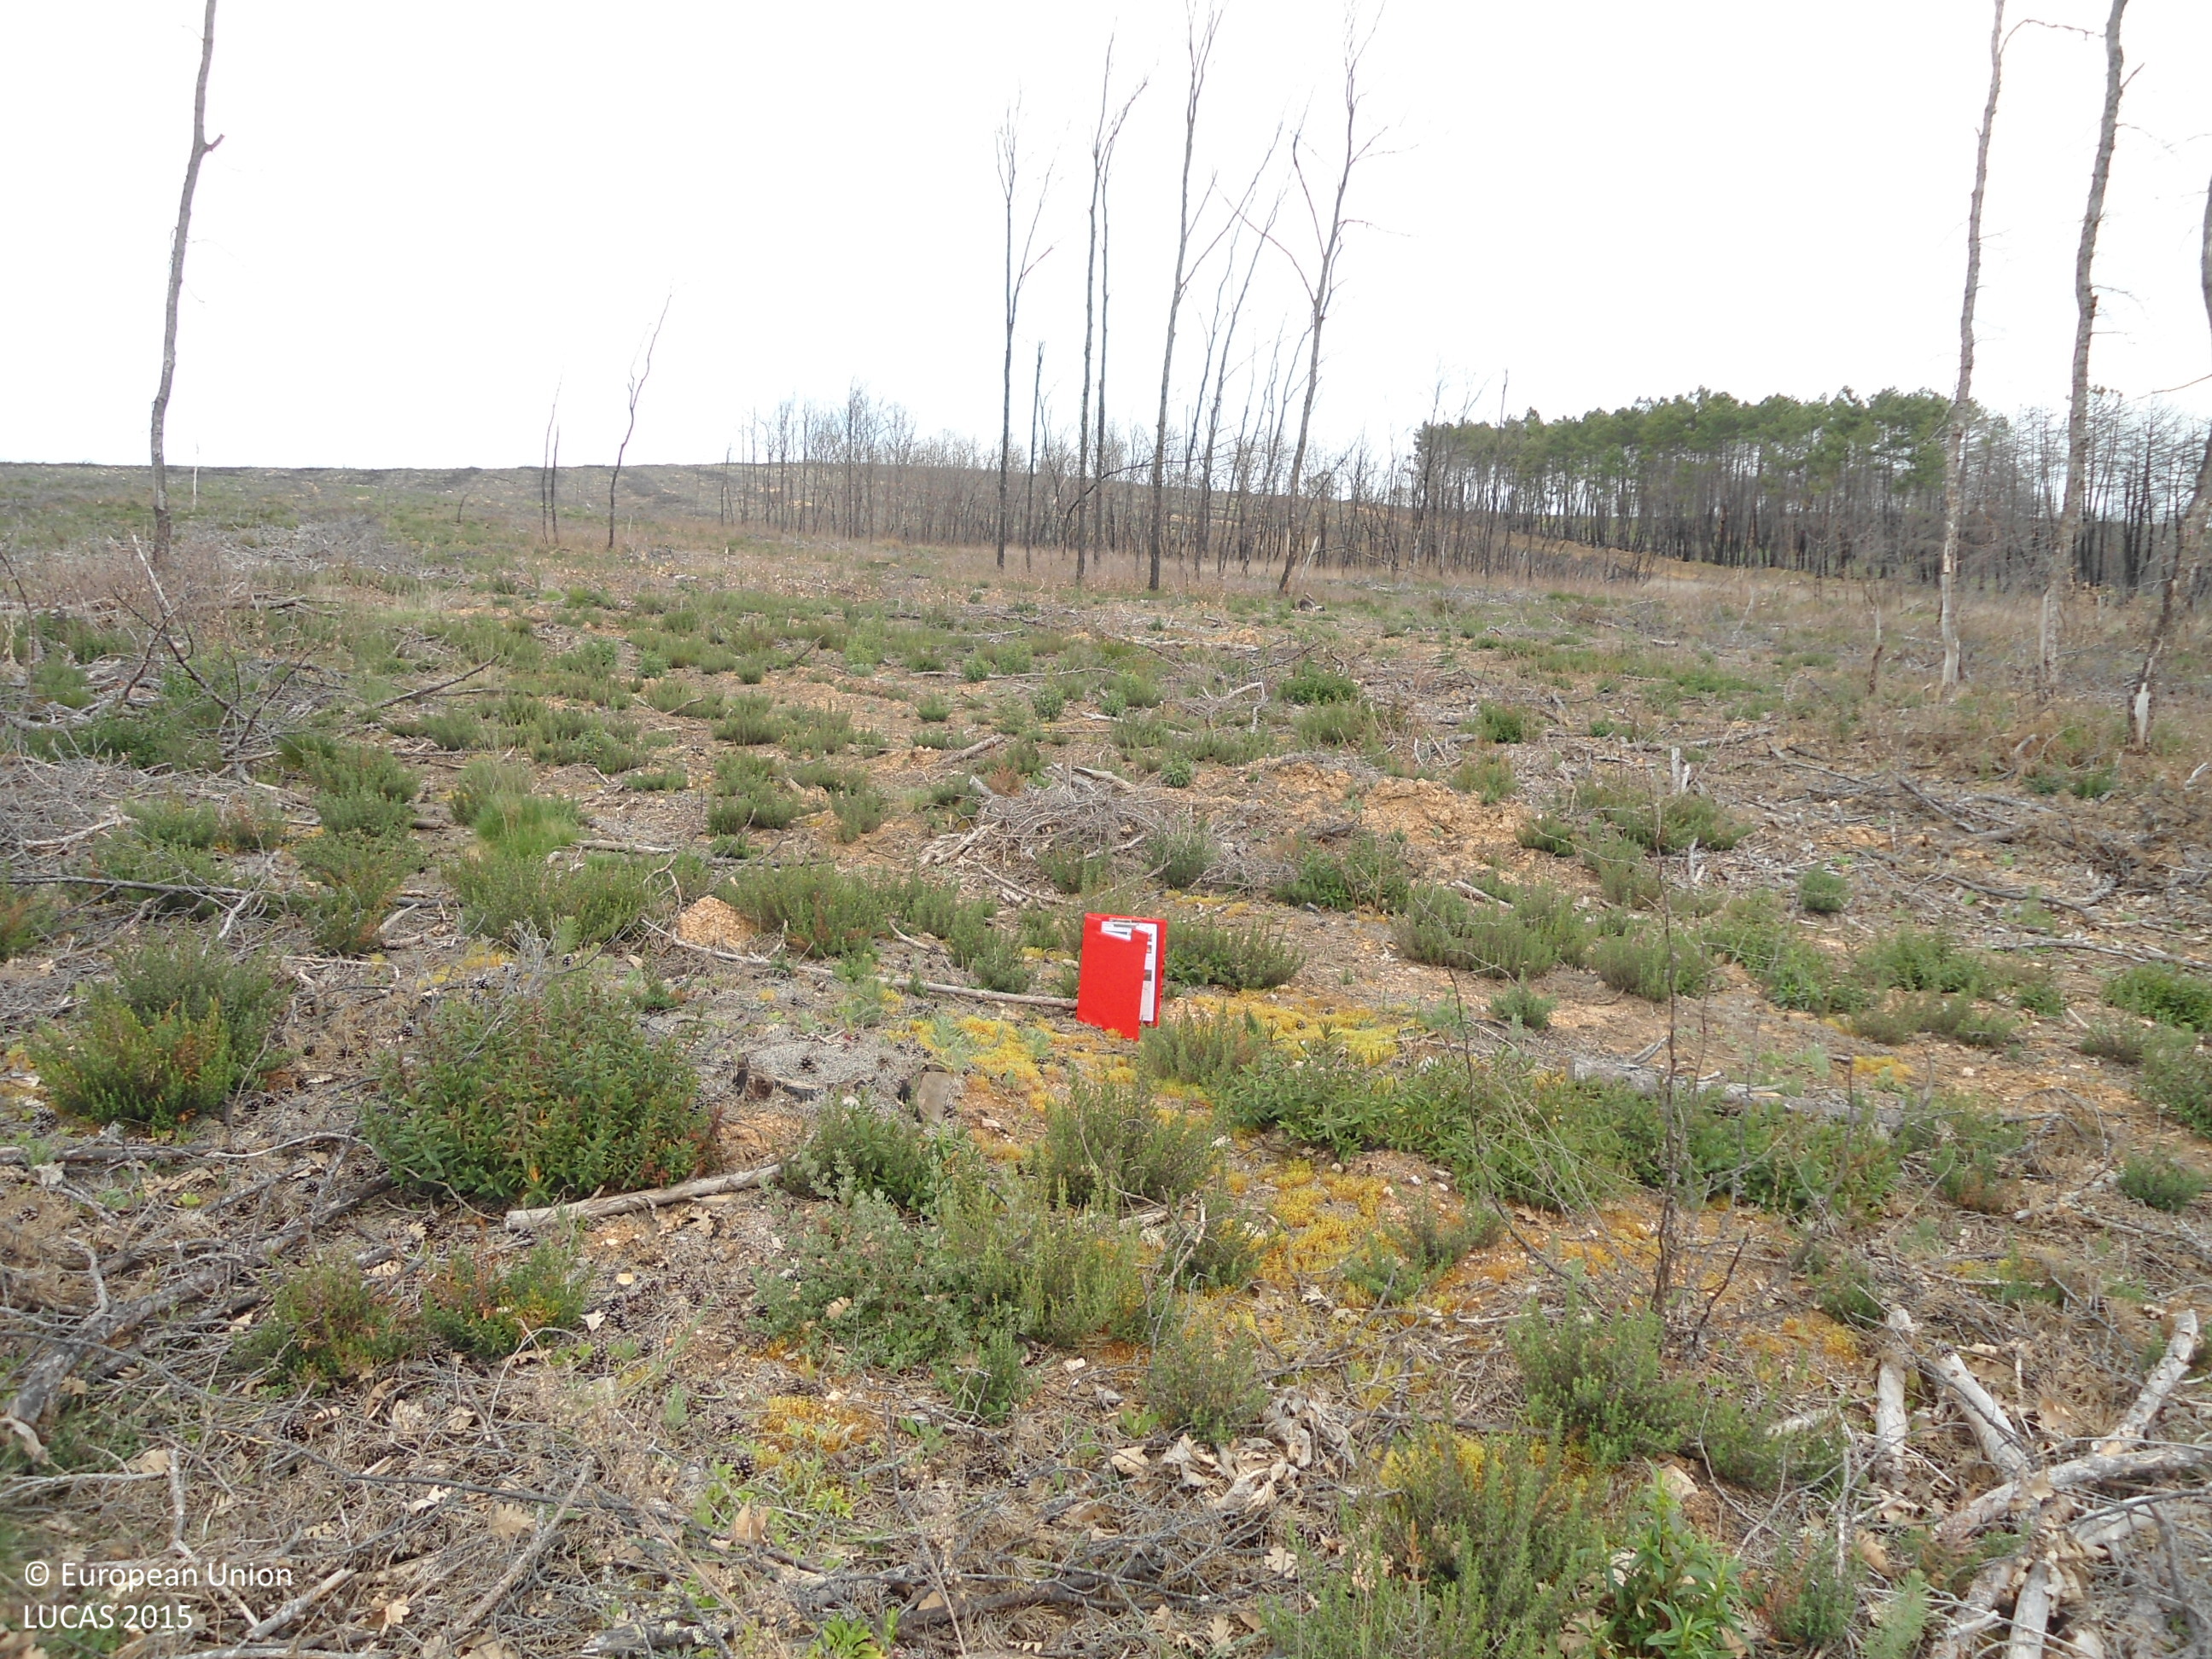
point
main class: Shrubland
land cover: Shrubland without tree cover
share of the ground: > 75 %
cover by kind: shrubs 100 %
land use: Forestry
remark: Burnt area
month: April
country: ES
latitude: 41.6582
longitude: -6.2757
